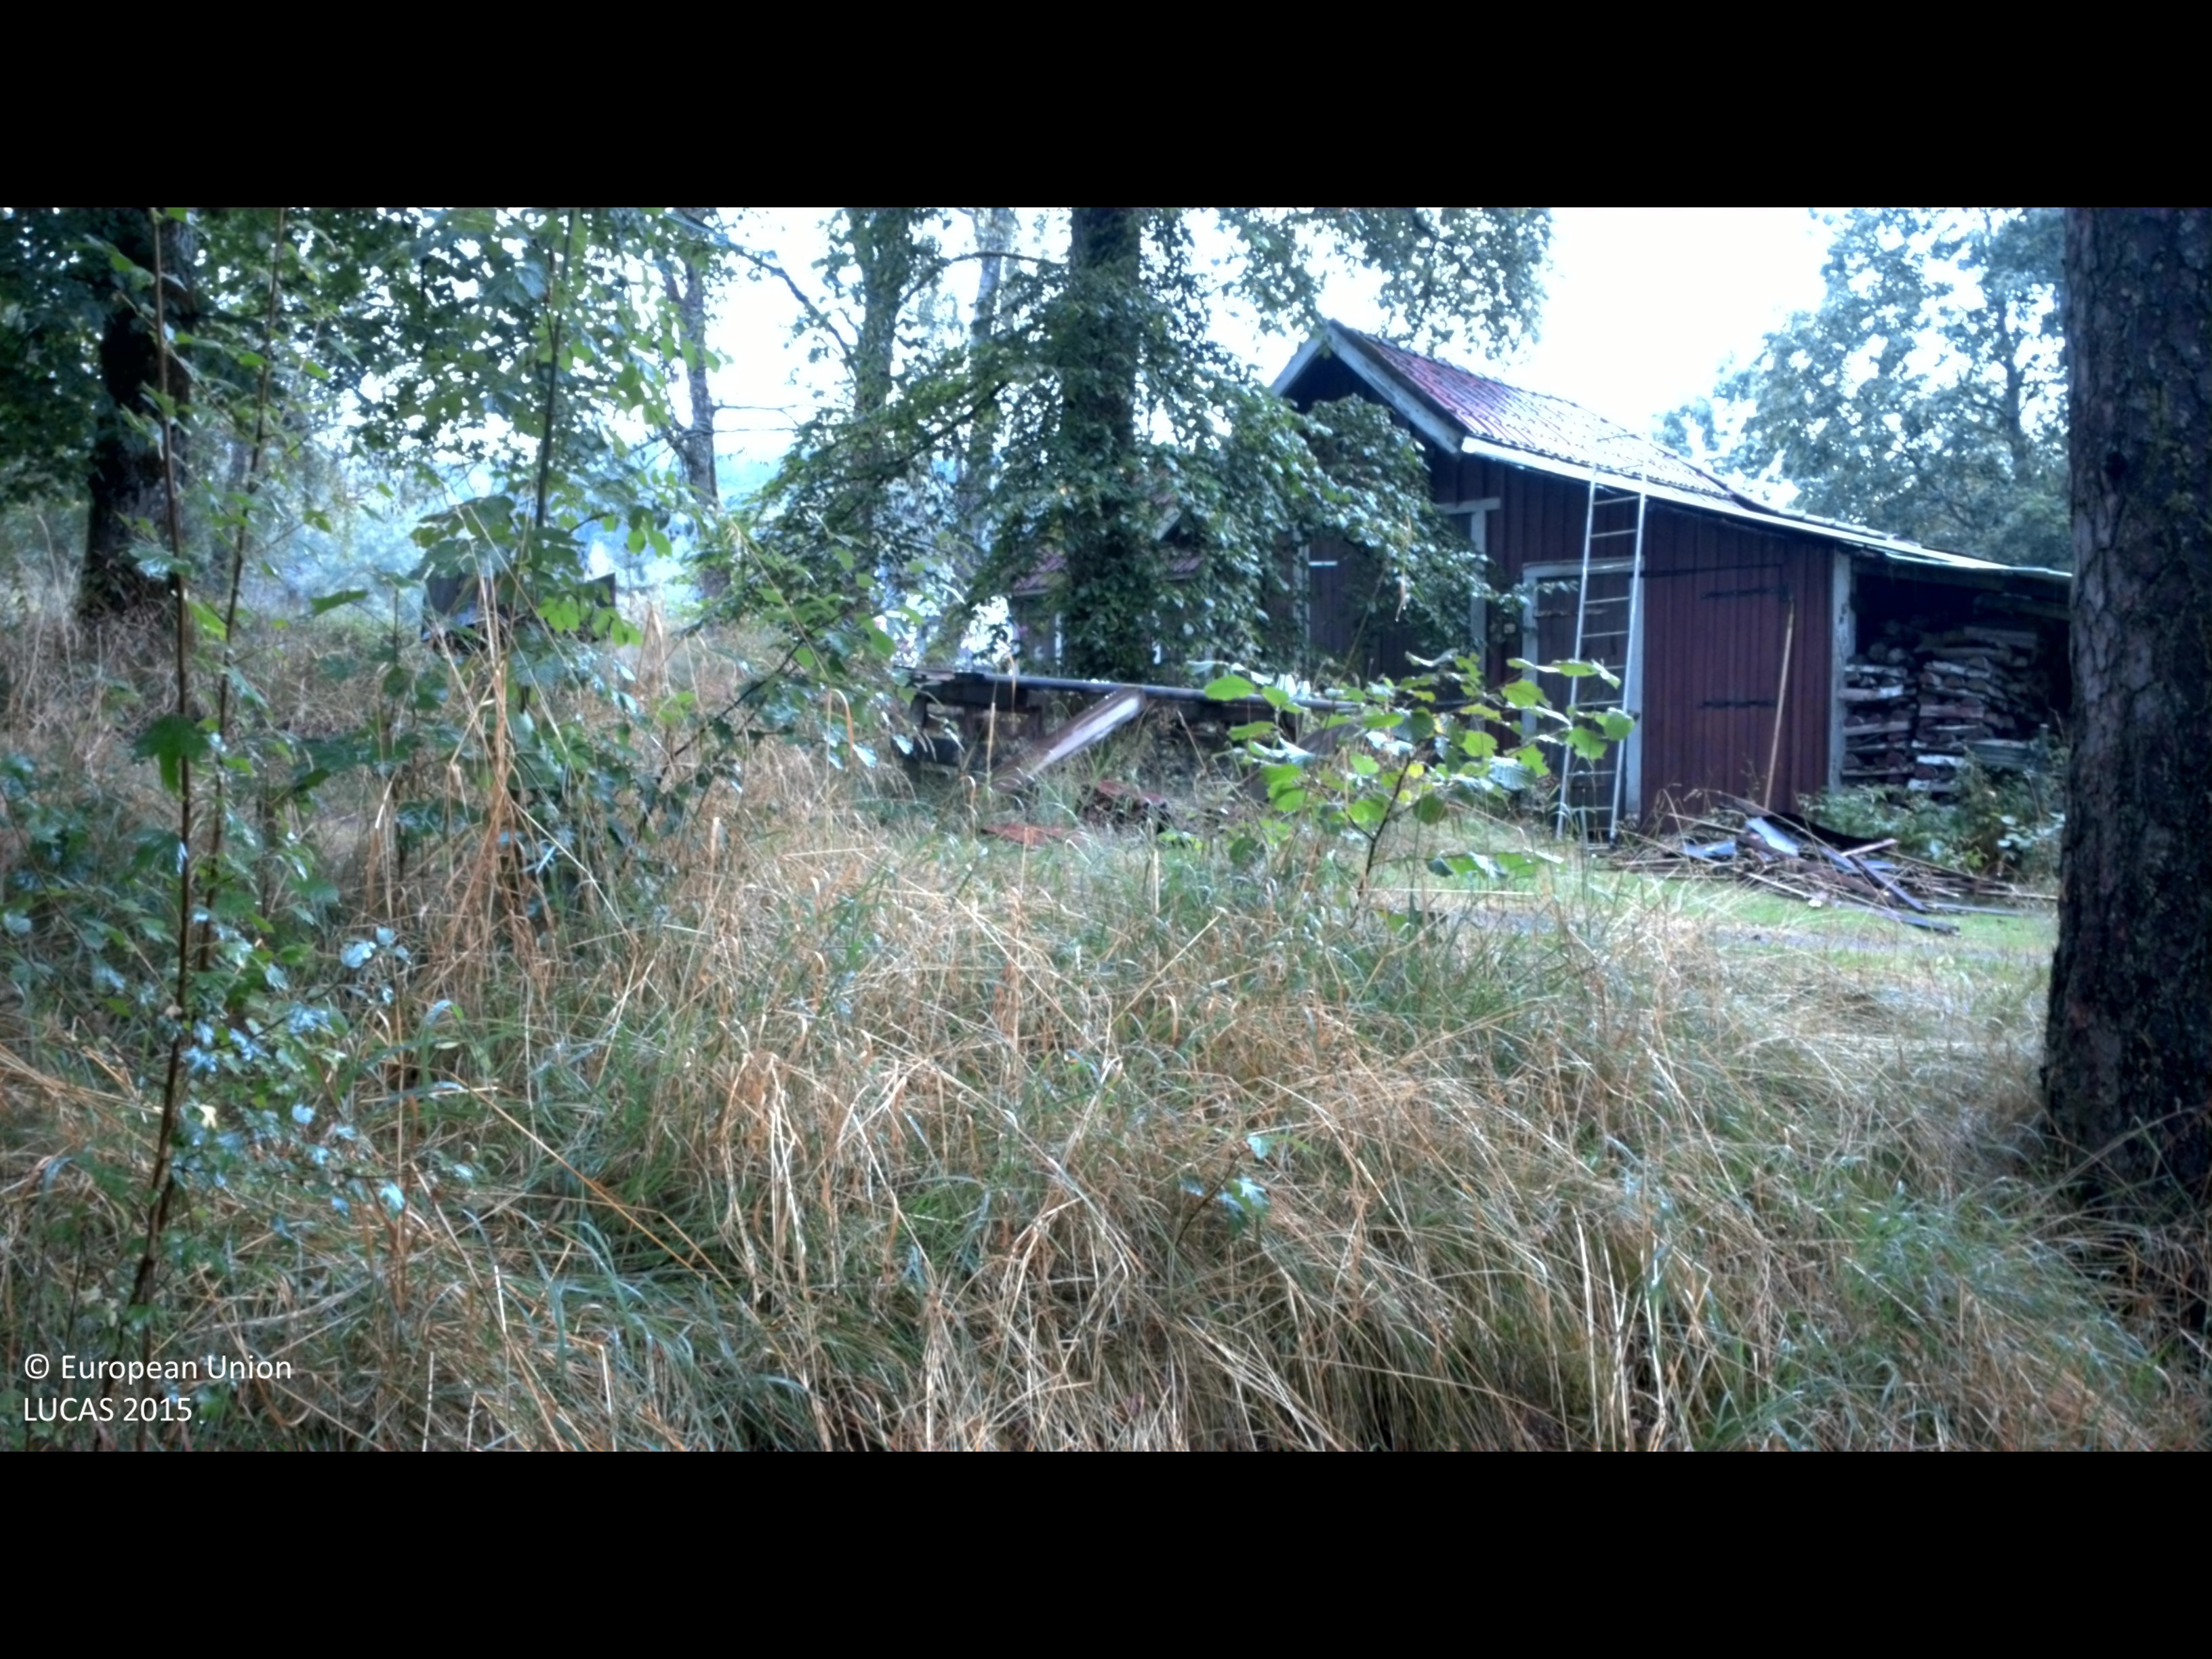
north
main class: Woodland
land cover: Pine dominated mixed woodland
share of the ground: 50 - 75 %
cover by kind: coniferous forest trees 45 %, herbaceous plants 25 %, broadleaved forest trees 20 %, shrubs 10 %
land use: Residential
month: August
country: SE
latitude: 56.9591
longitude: 13.1374
